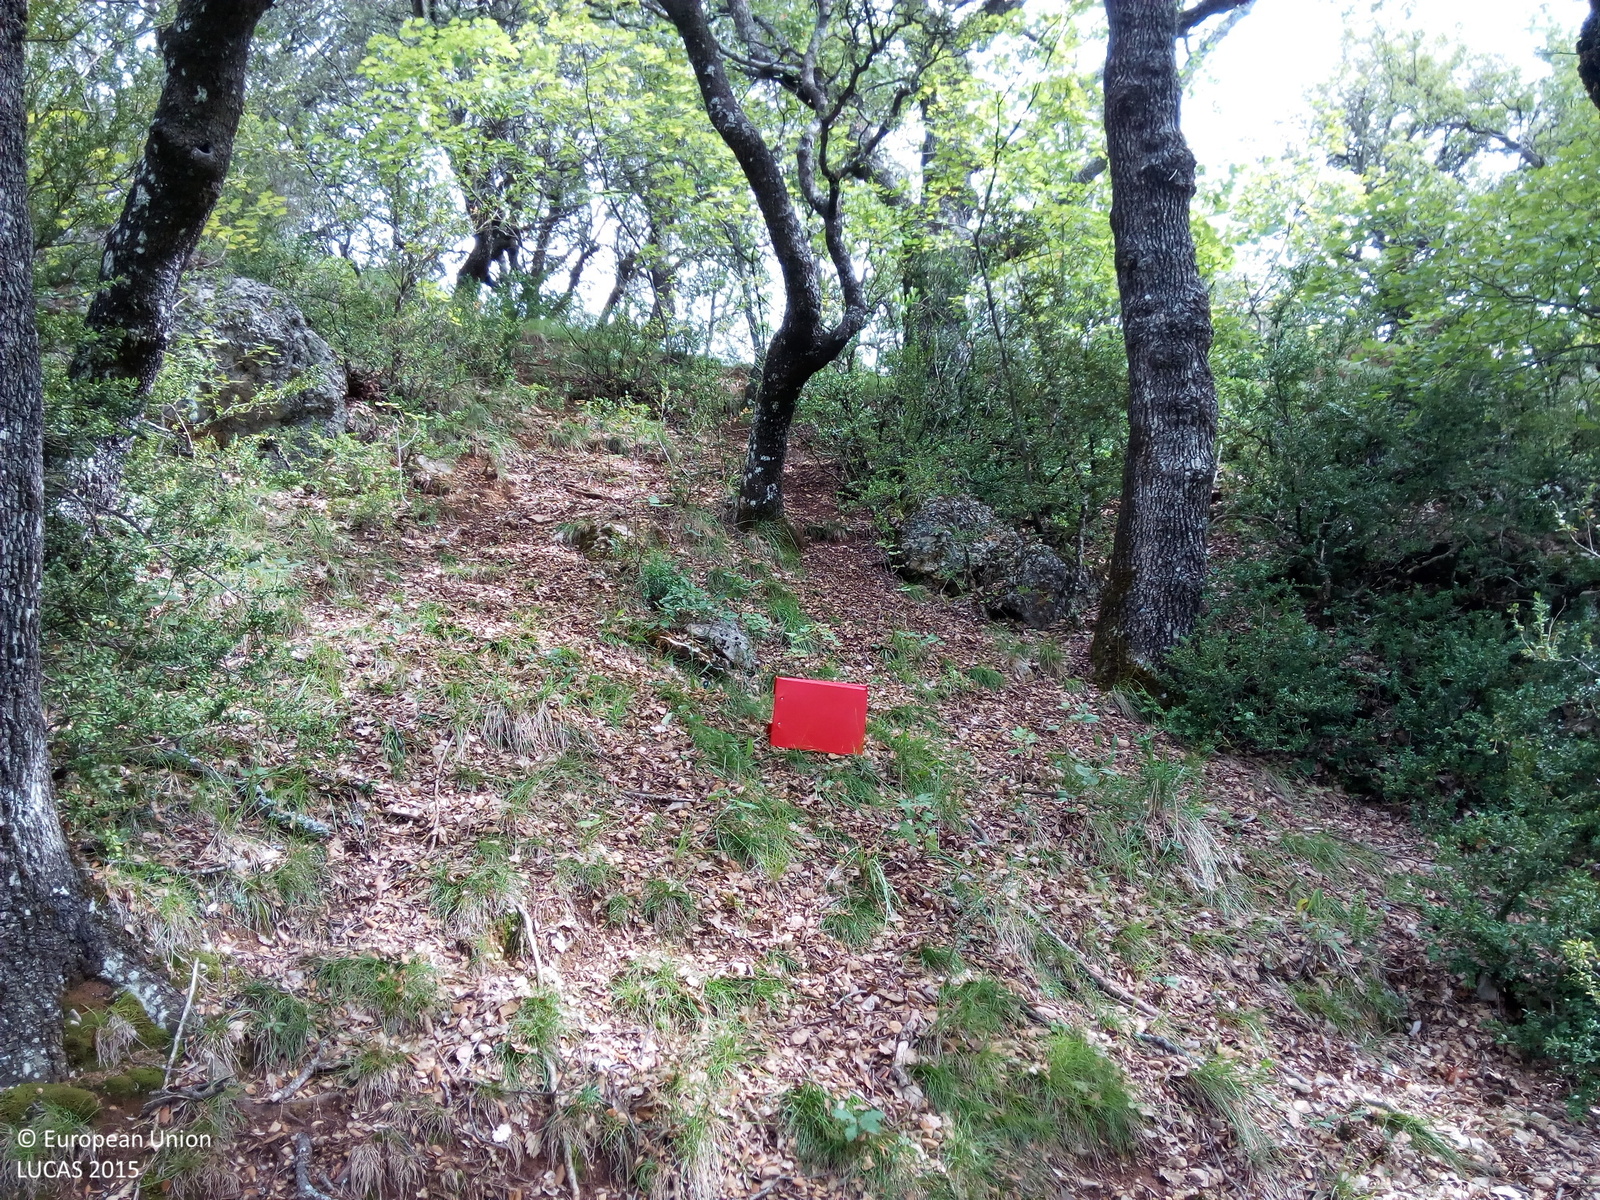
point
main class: Woodland
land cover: Broadleaved woodland
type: acidophilous oak and oak-birch forest
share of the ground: > 75 %
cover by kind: broadleaved forest trees 85 %, shrubs 15 %
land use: Semi-natural and natural areas not in use
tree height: > 5 m
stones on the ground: 10 - 25 %
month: September
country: ES
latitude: 42.3878
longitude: 0.4944
